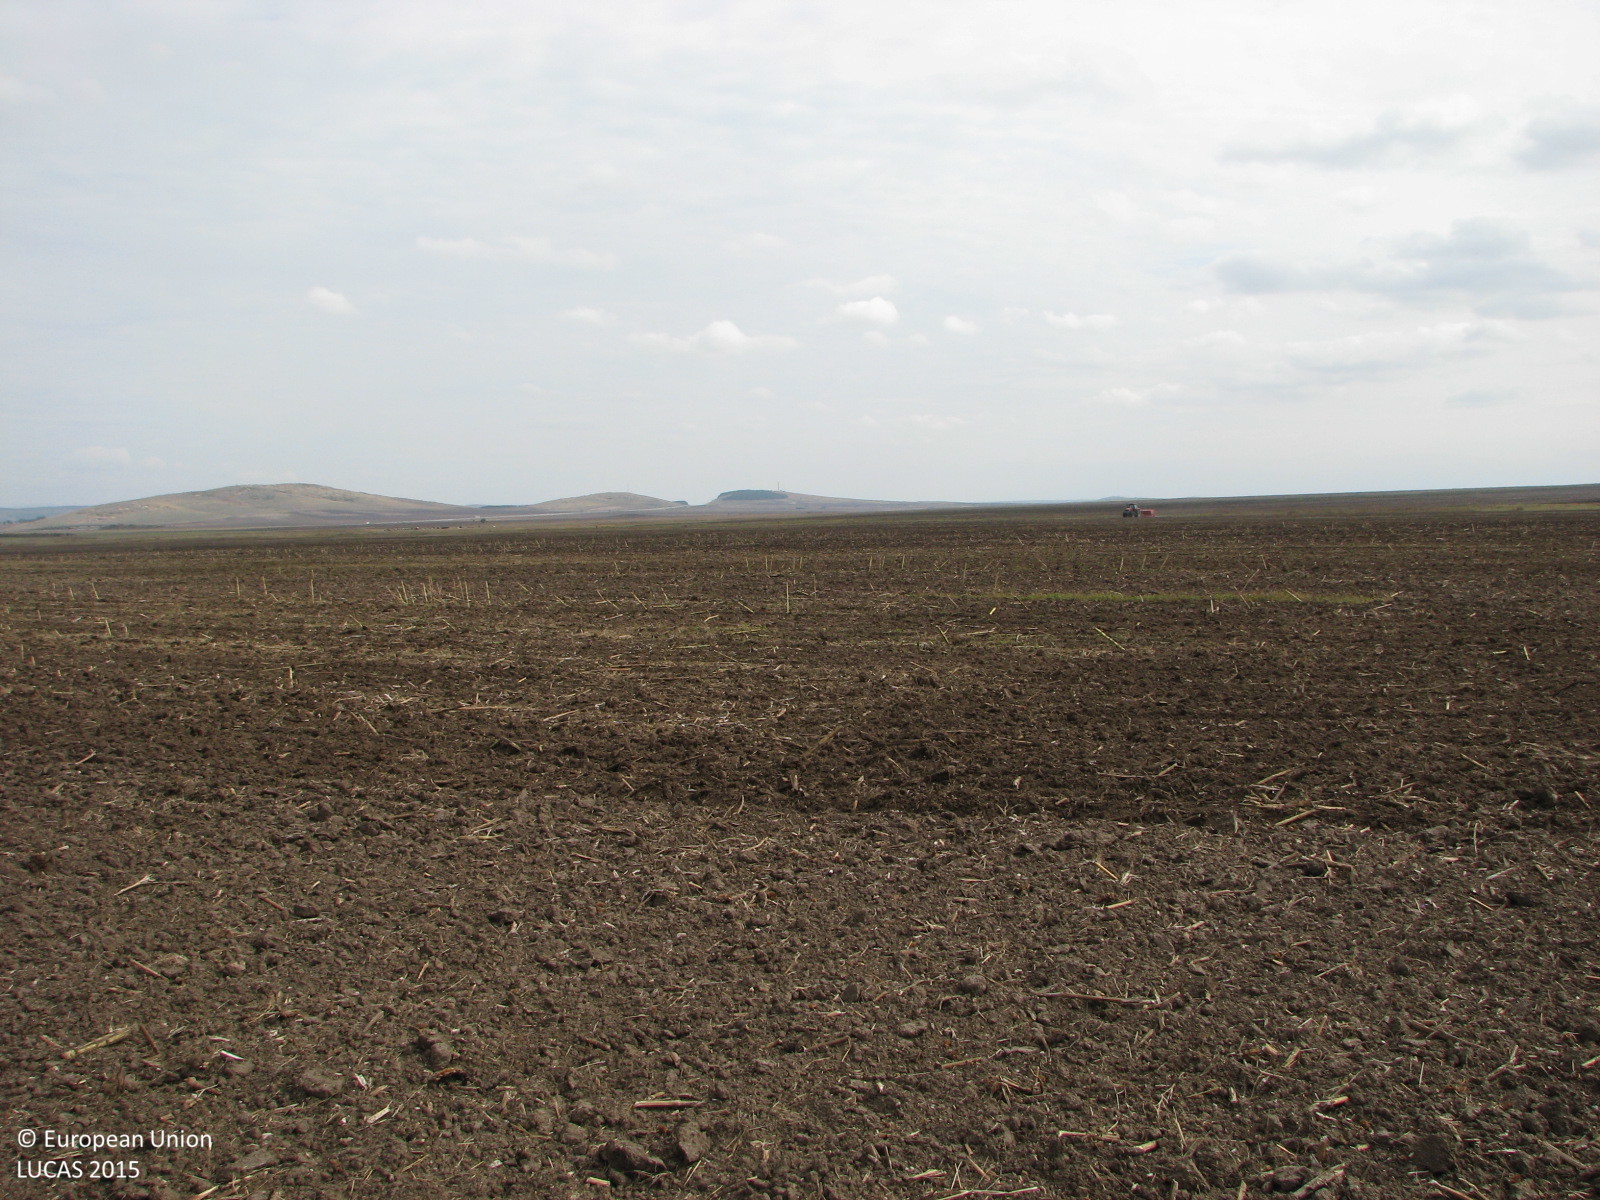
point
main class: Cropland
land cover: Sunflower
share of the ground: < 10 %
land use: Agriculture (excluding fallow land and kitchen gardens)
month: October
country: BG
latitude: 42.4789
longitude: 26.2030
